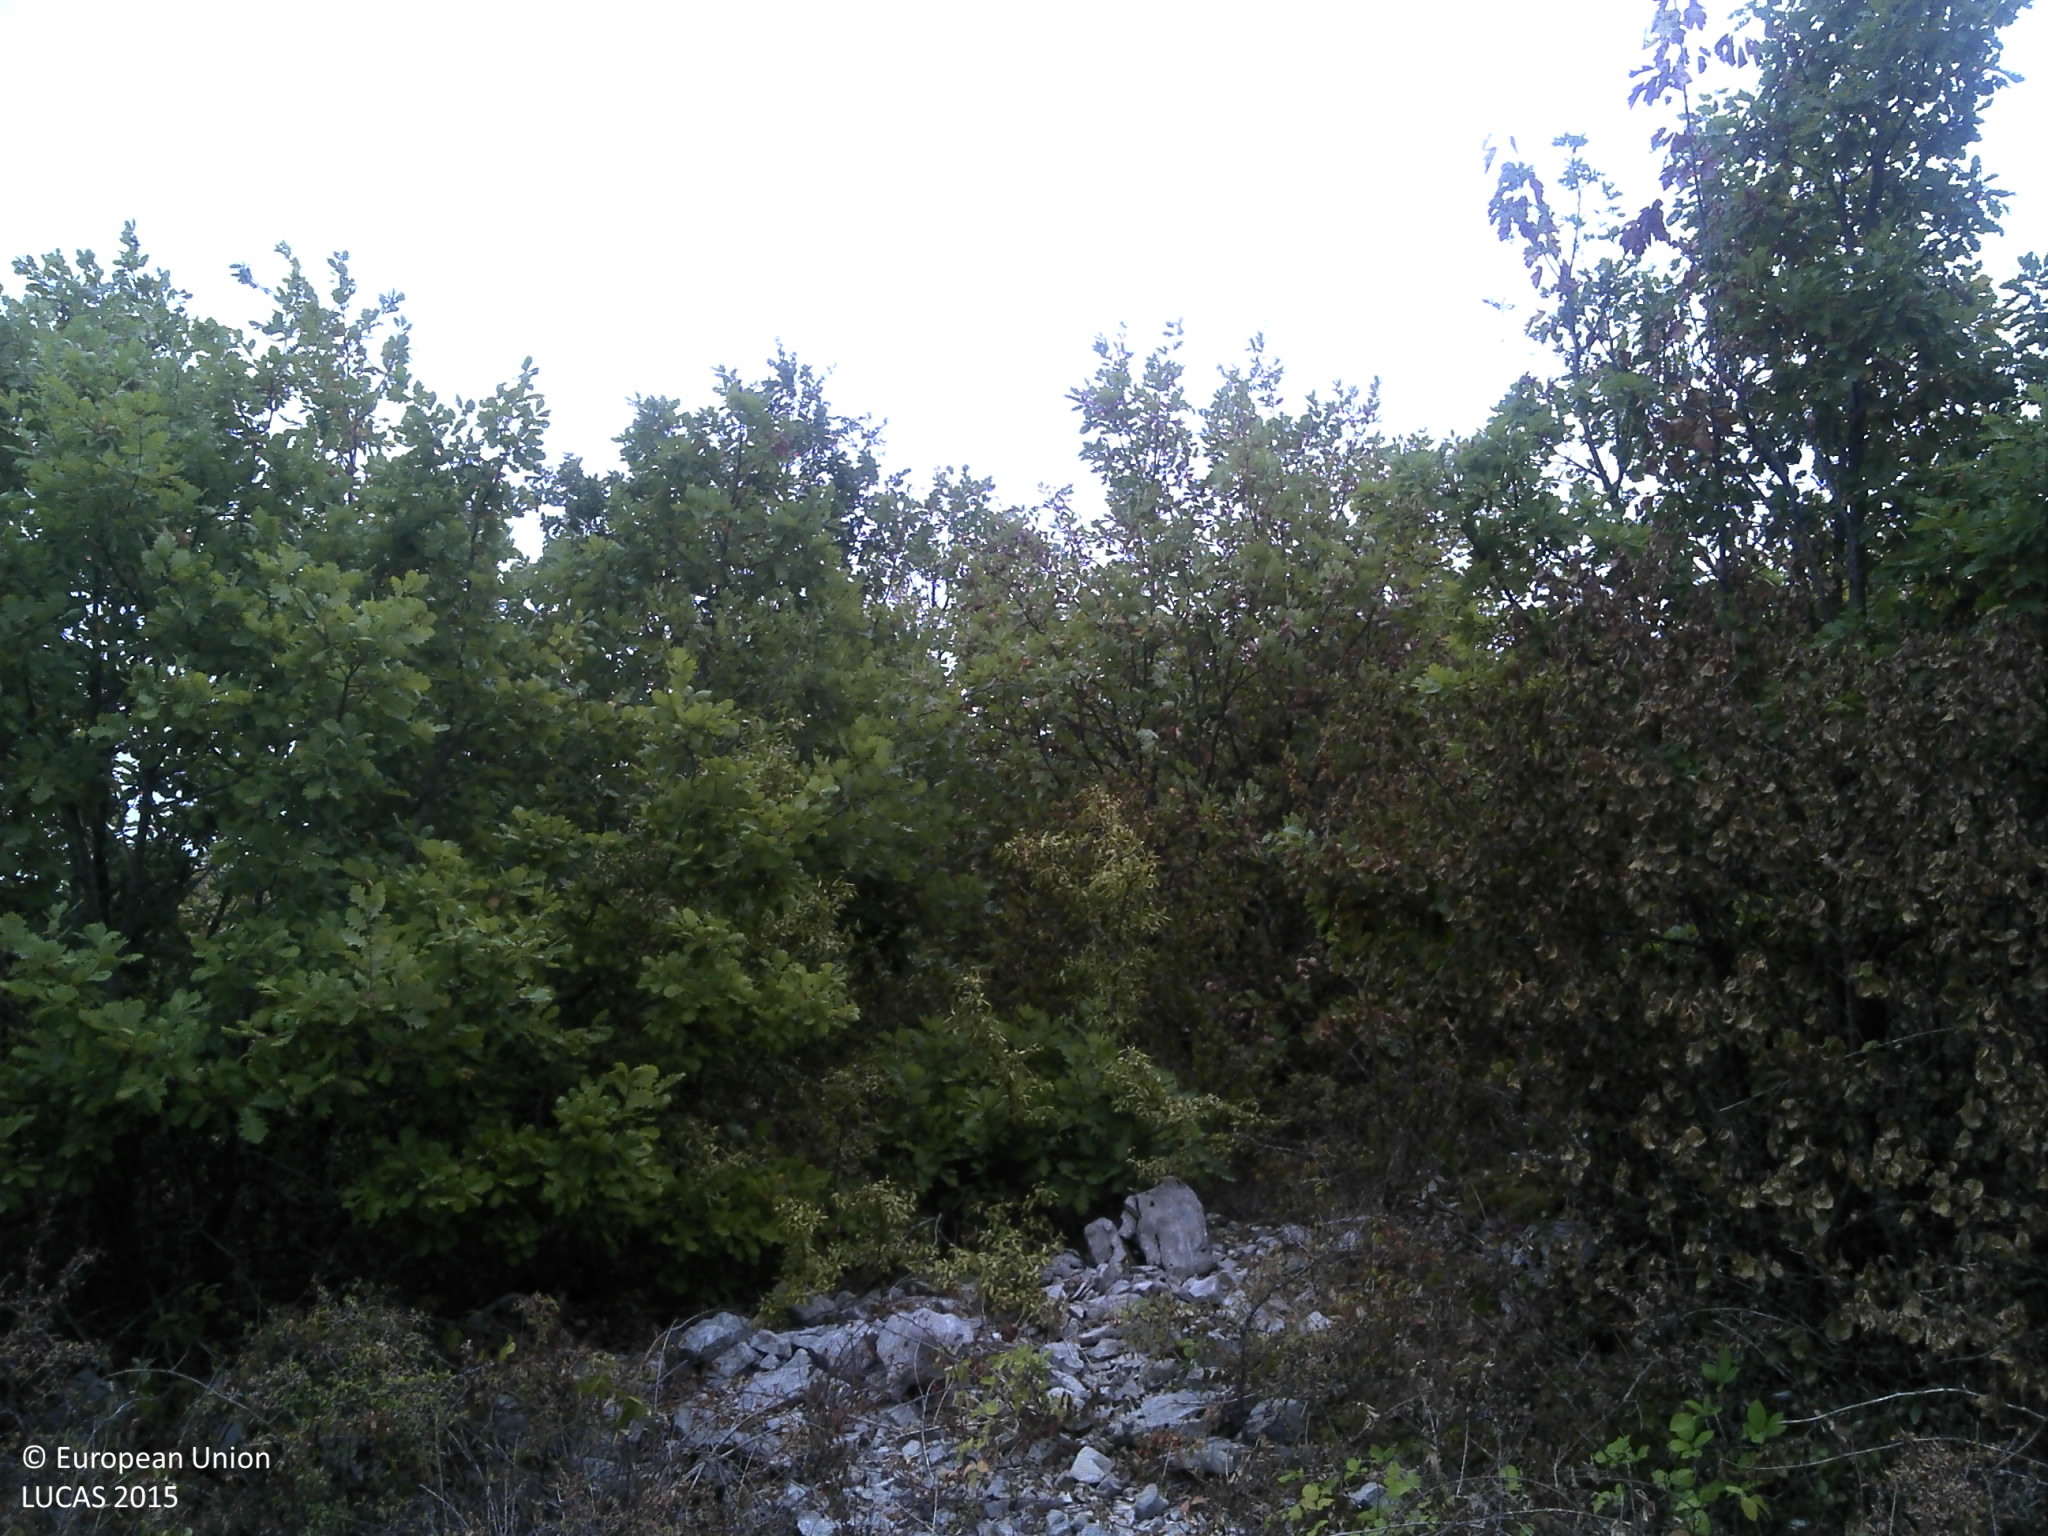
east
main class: Shrubland
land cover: Shrubland with sparse tree cover
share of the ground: > 75 %
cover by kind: shrubs 50 %, herbaceous plants 40 %, broadleaved forest trees 5 %, lichens and mosses 5 %
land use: Semi-natural and natural areas not in use
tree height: < 5 m
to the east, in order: Shrubland with sparse tree cover; Broadleaved woodland
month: July
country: FR
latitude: 45.0821
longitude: 1.4198
